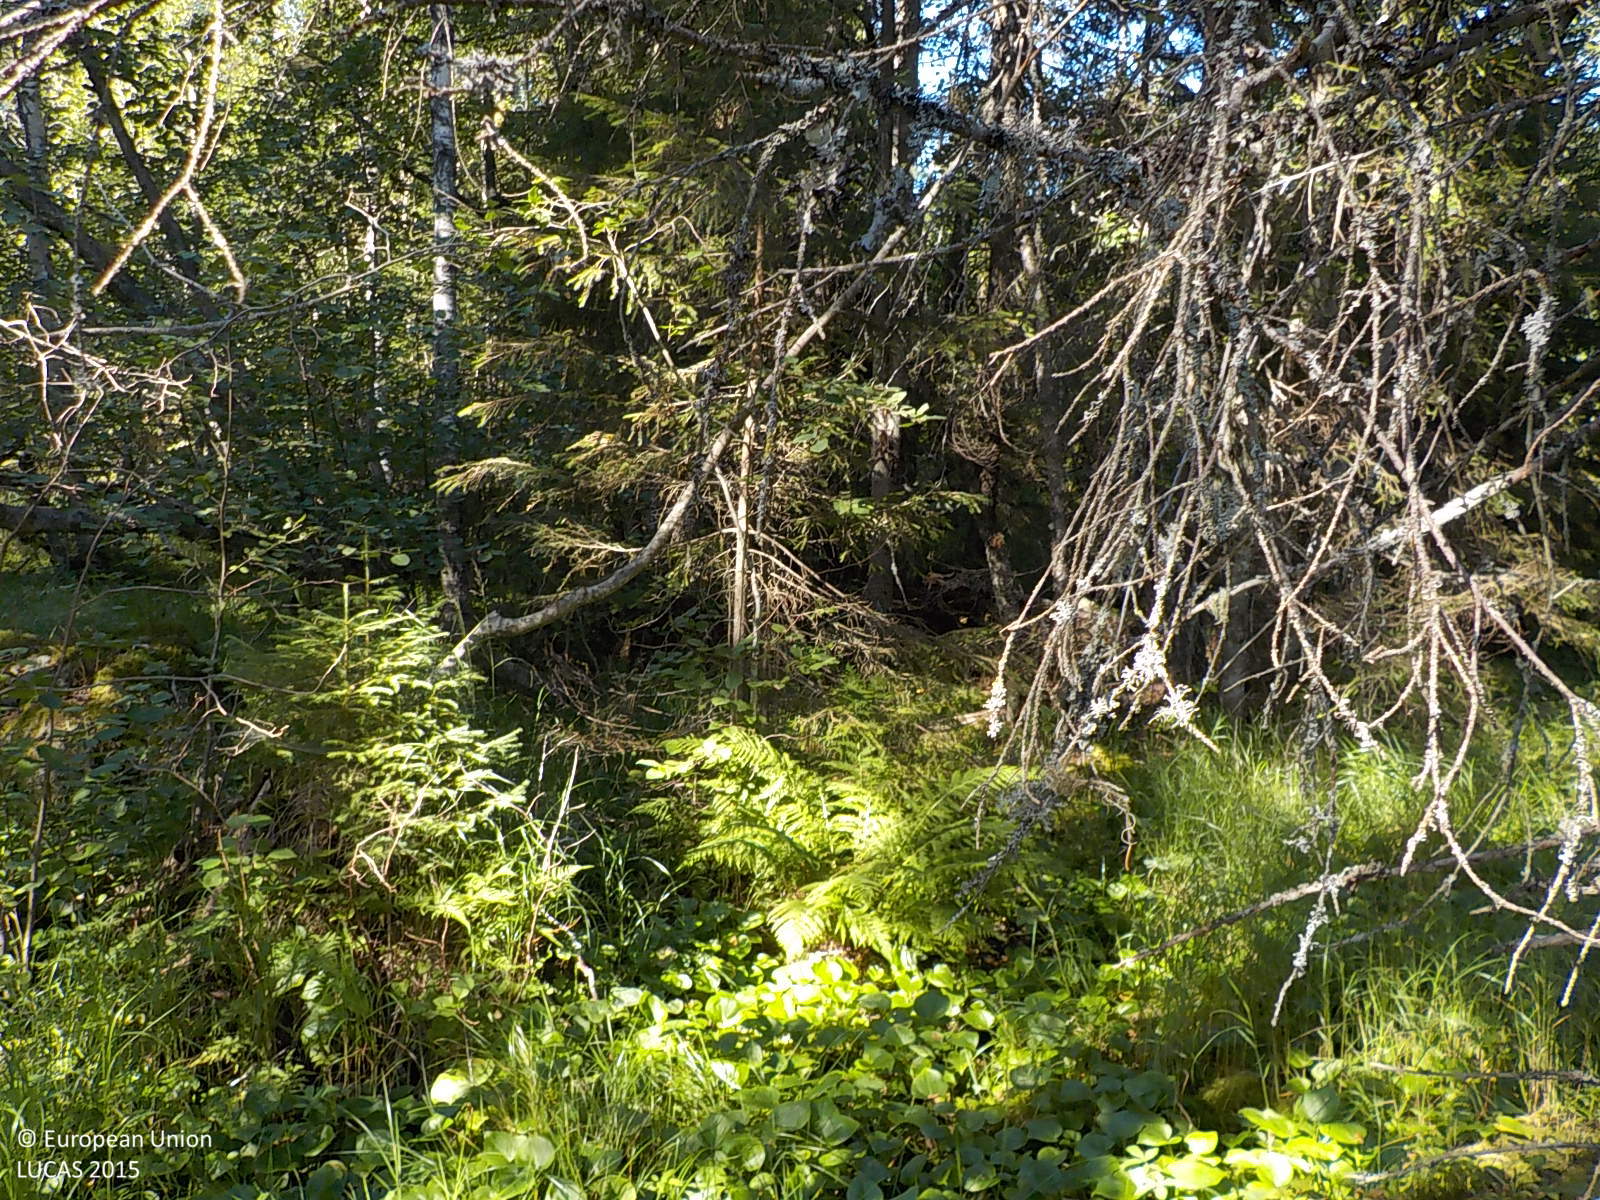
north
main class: Woodland
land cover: Spruce dominated coniferous woodland
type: boreal forest
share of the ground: > 75 %
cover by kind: coniferous forest trees 85 %, herbaceous plants 15 %
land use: Forestry
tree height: > 5 m
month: August
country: SE
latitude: 63.3966
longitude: 18.6841
